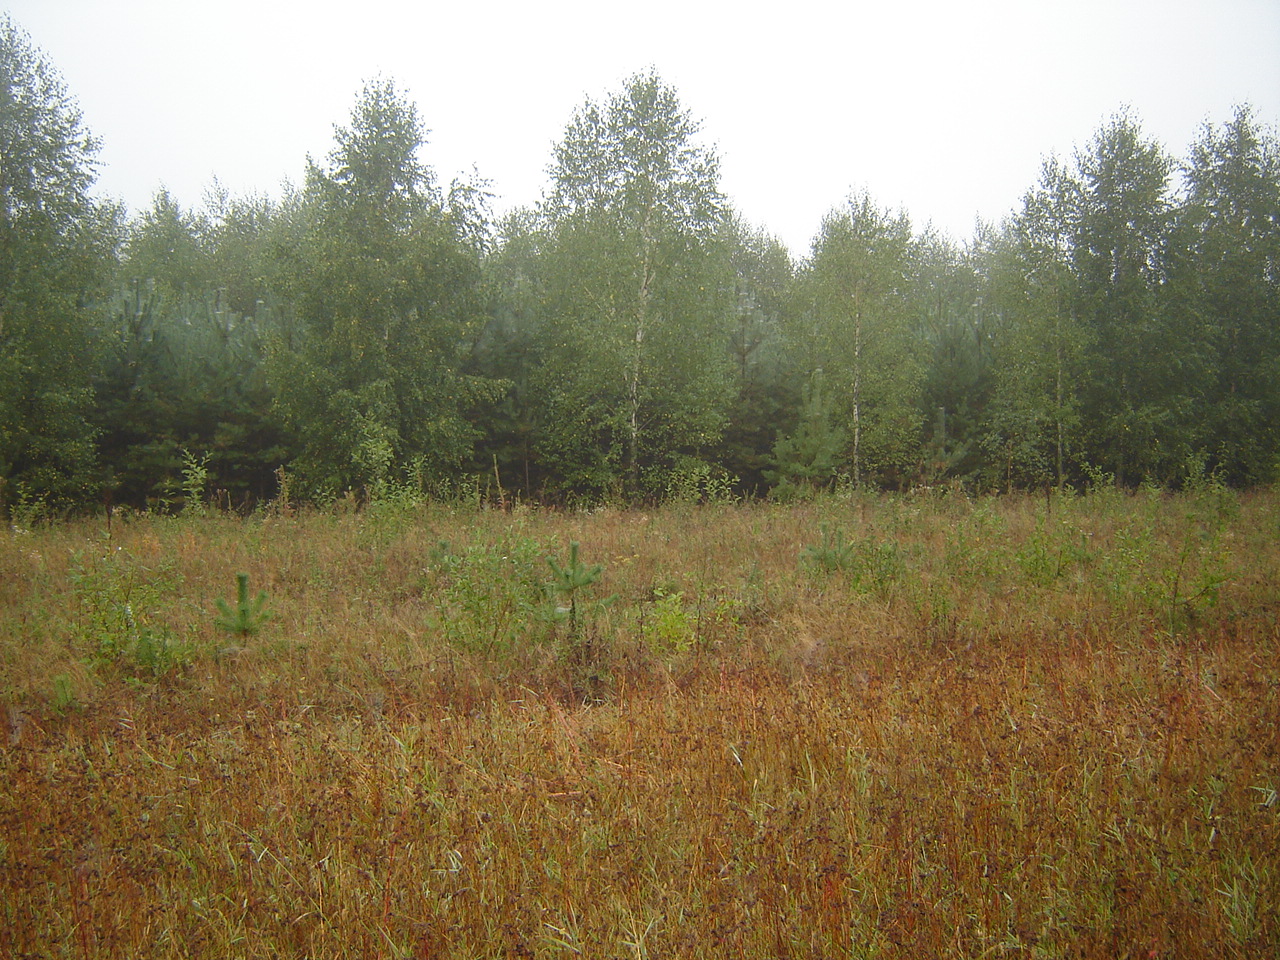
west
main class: Cropland
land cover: Other cereals
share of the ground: > 75 %
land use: Agriculture (excluding fallow land and kitchen gardens)
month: September
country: LT
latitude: 54.2640
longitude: 24.7720
